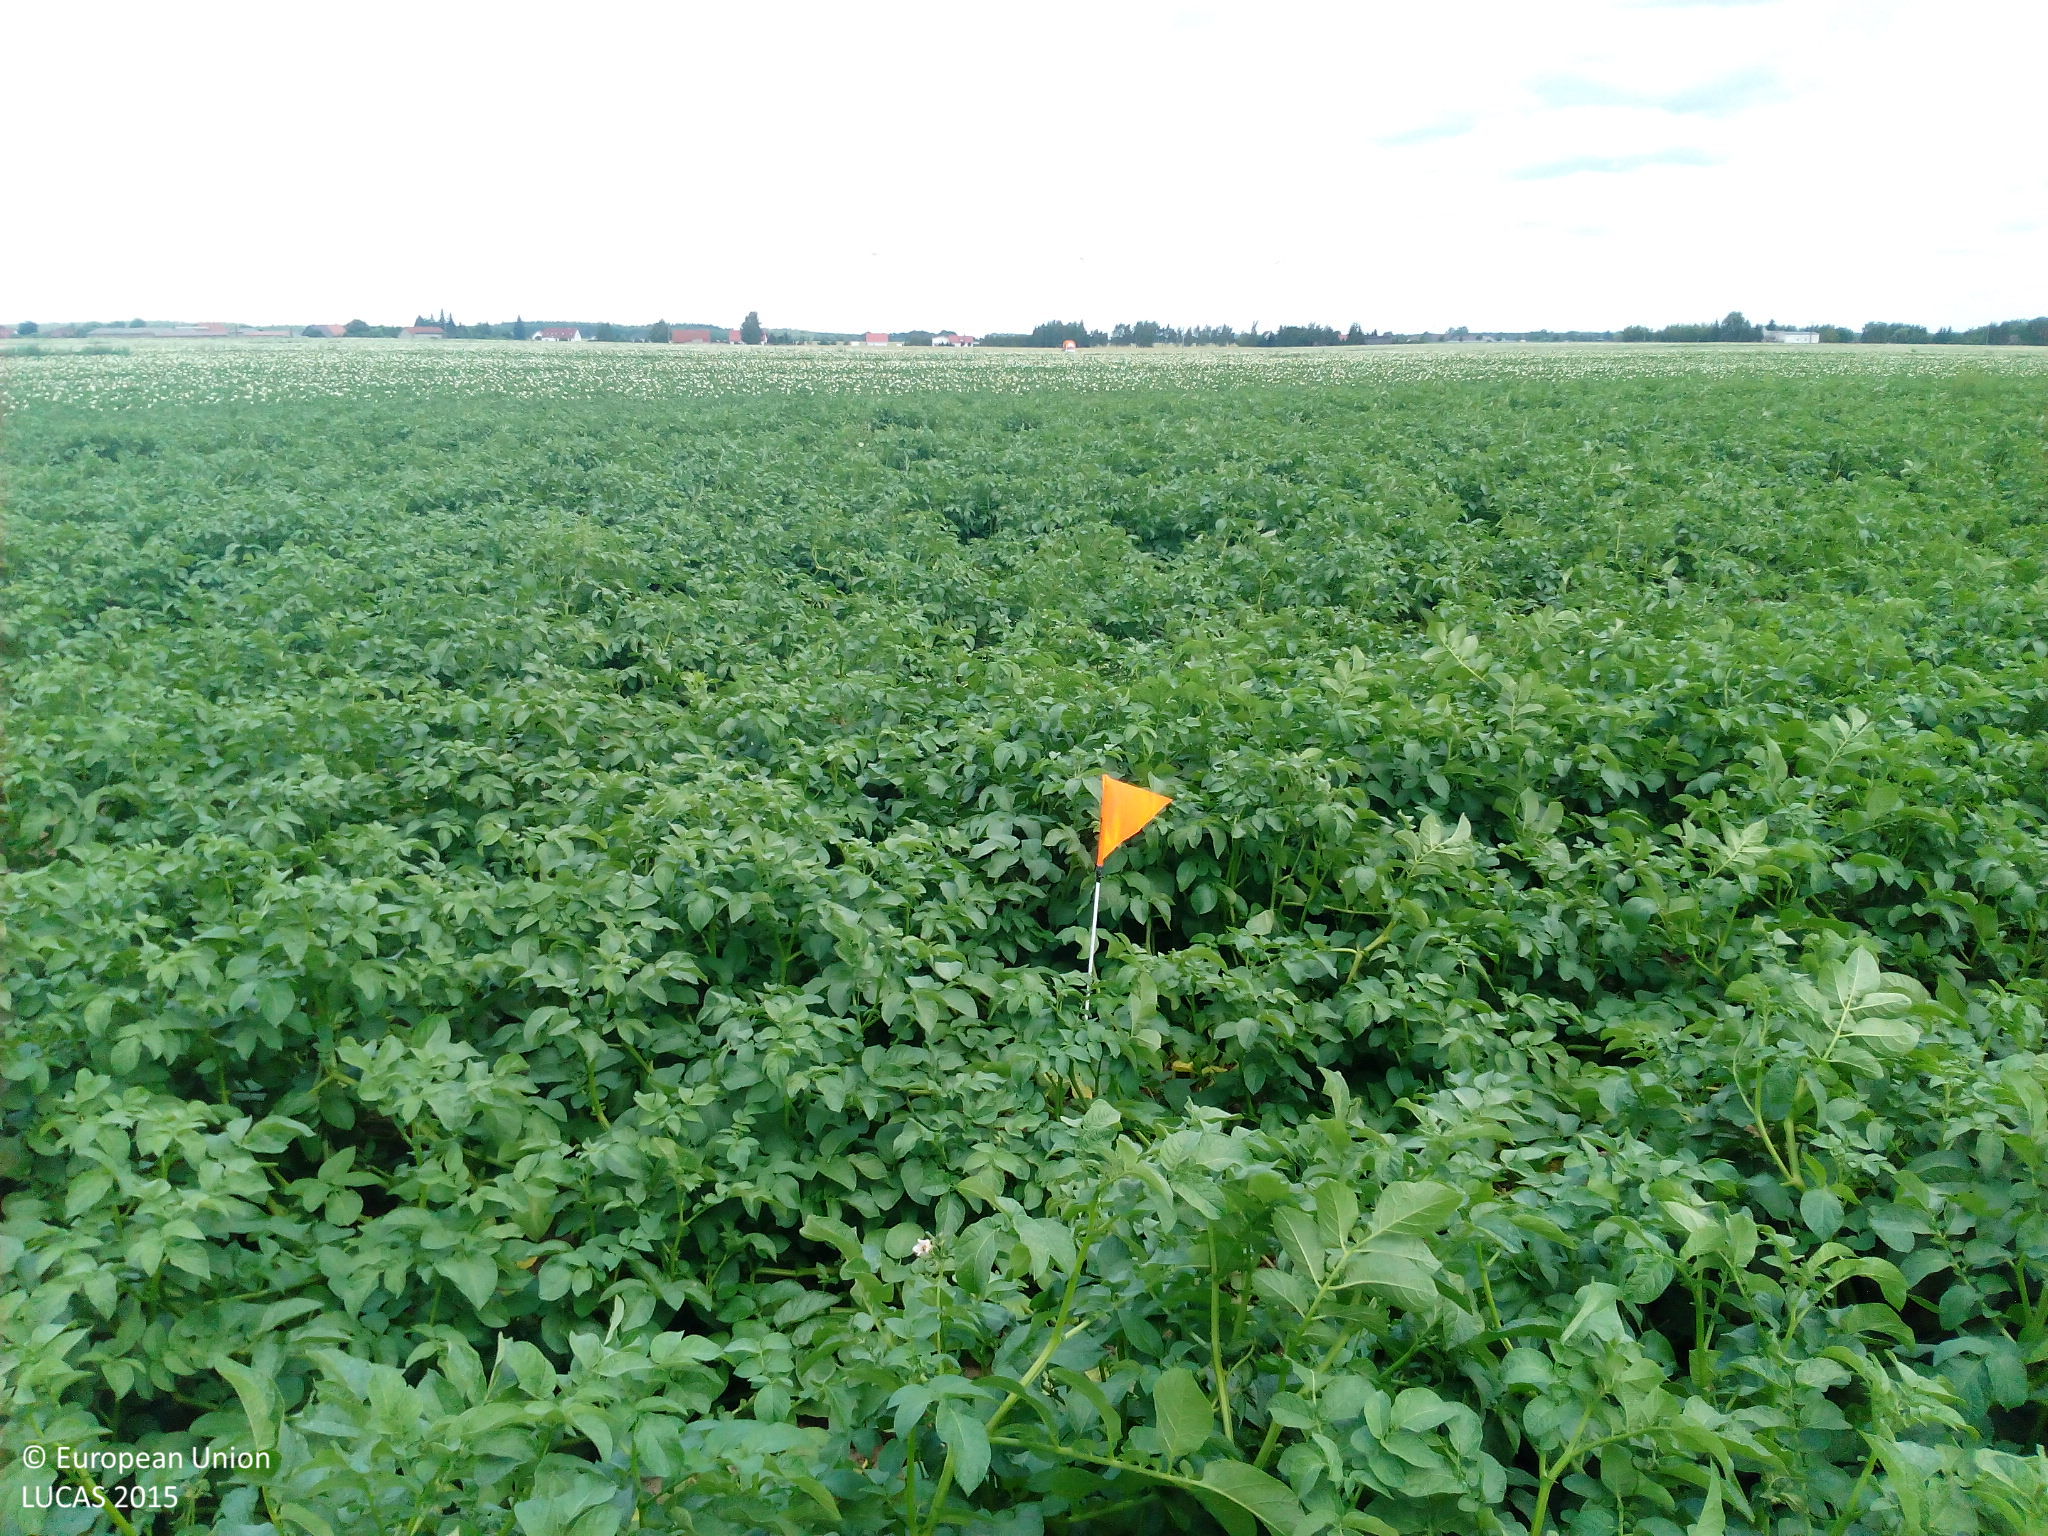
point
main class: Cropland
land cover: Potatoes
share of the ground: > 75 %
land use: Agriculture (excluding fallow land and kitchen gardens)
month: July
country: DE
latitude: 53.9333
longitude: 13.2741
